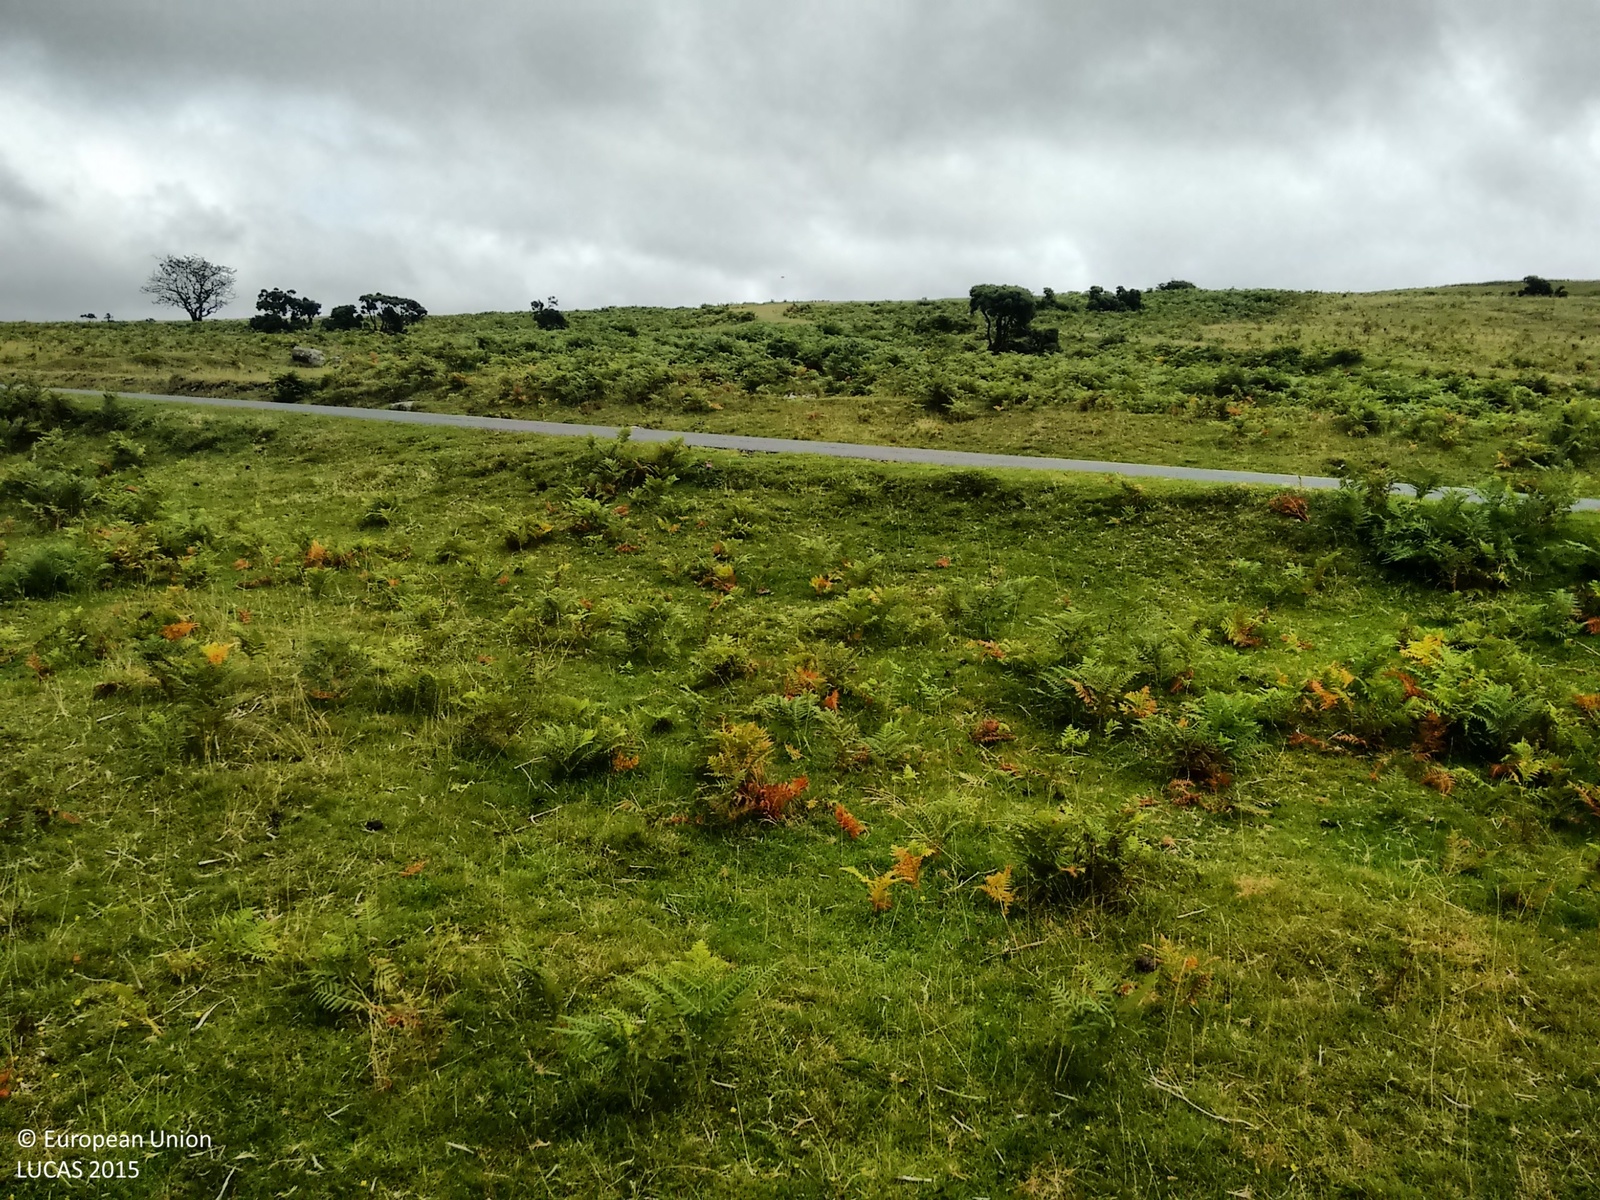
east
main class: Grassland
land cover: Grassland without tree/shrub cover
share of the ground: > 75 %
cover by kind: herbaceous plants 100 %
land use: Agriculture (excluding fallow land and kitchen gardens)
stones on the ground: < 10 %
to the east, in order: Grassland without tree/shrub cover; Paved roads, cycling and walking lanes; Grassland without tree/shrub cover
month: August
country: GB
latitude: 50.5146
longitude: -4.0421
